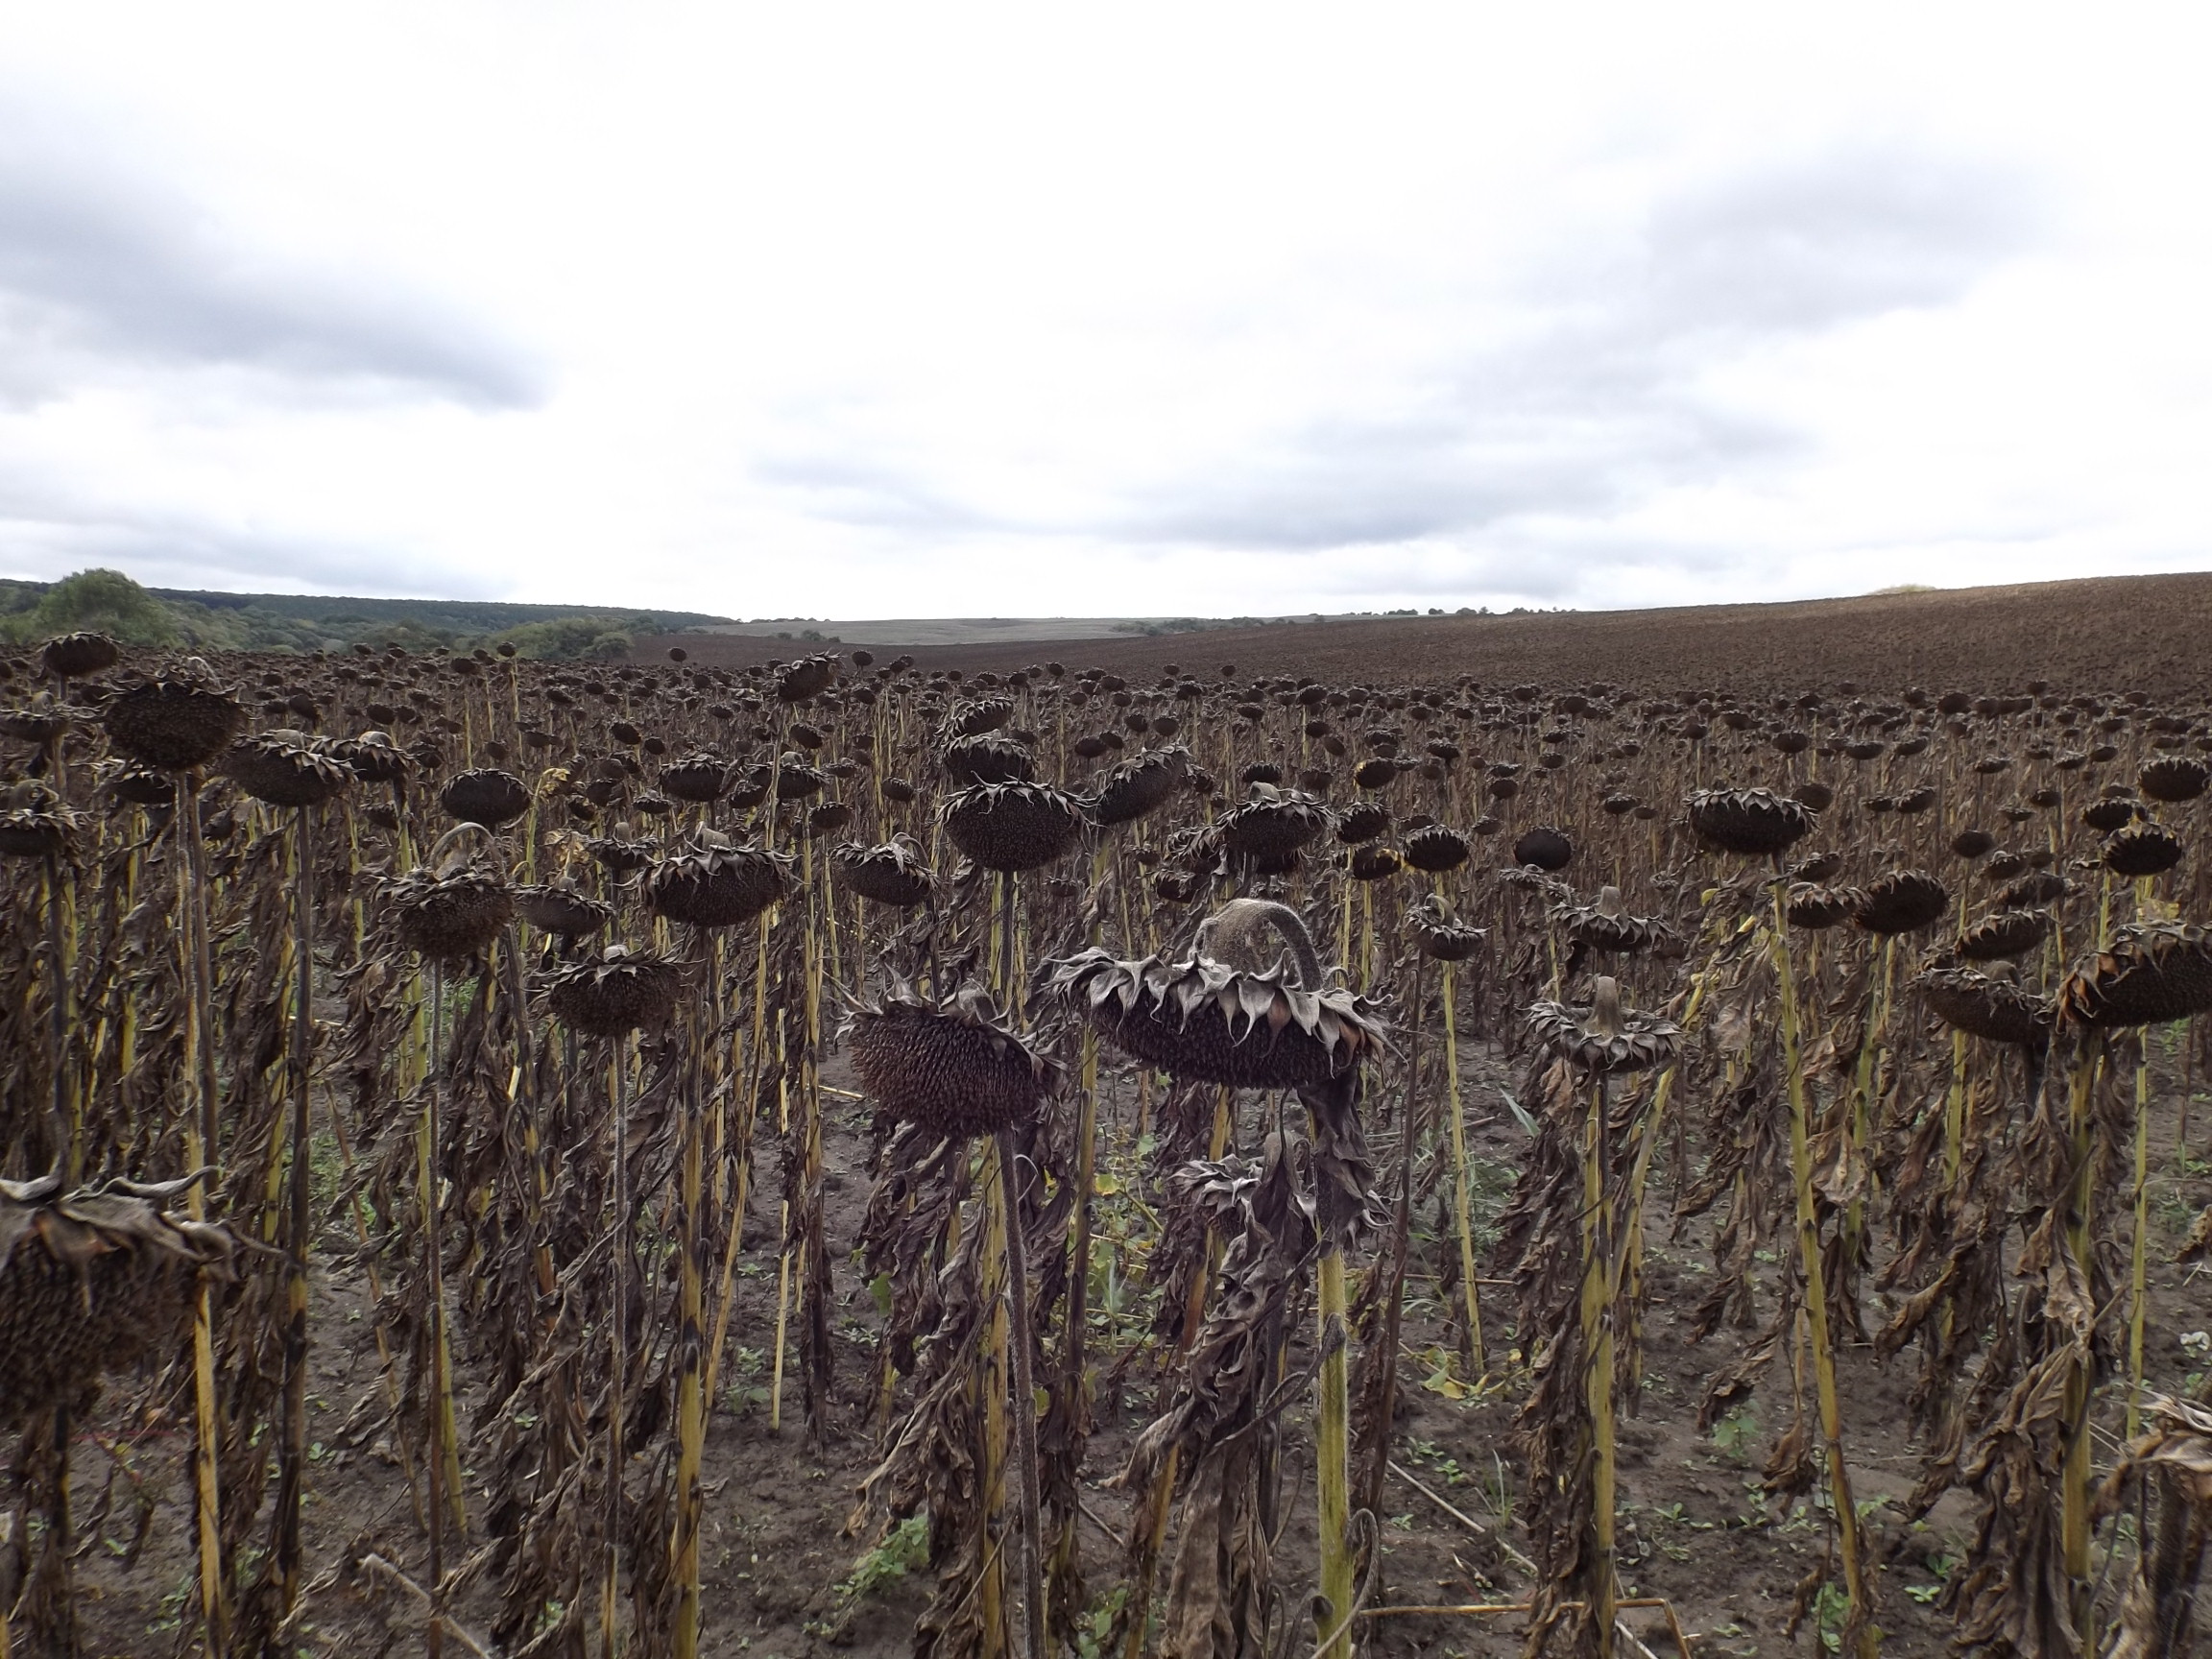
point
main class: Cropland
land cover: Sunflower
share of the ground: > 75 %
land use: Agriculture (excluding fallow land and kitchen gardens)
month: September
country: BG
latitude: 43.0873
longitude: 27.5080
